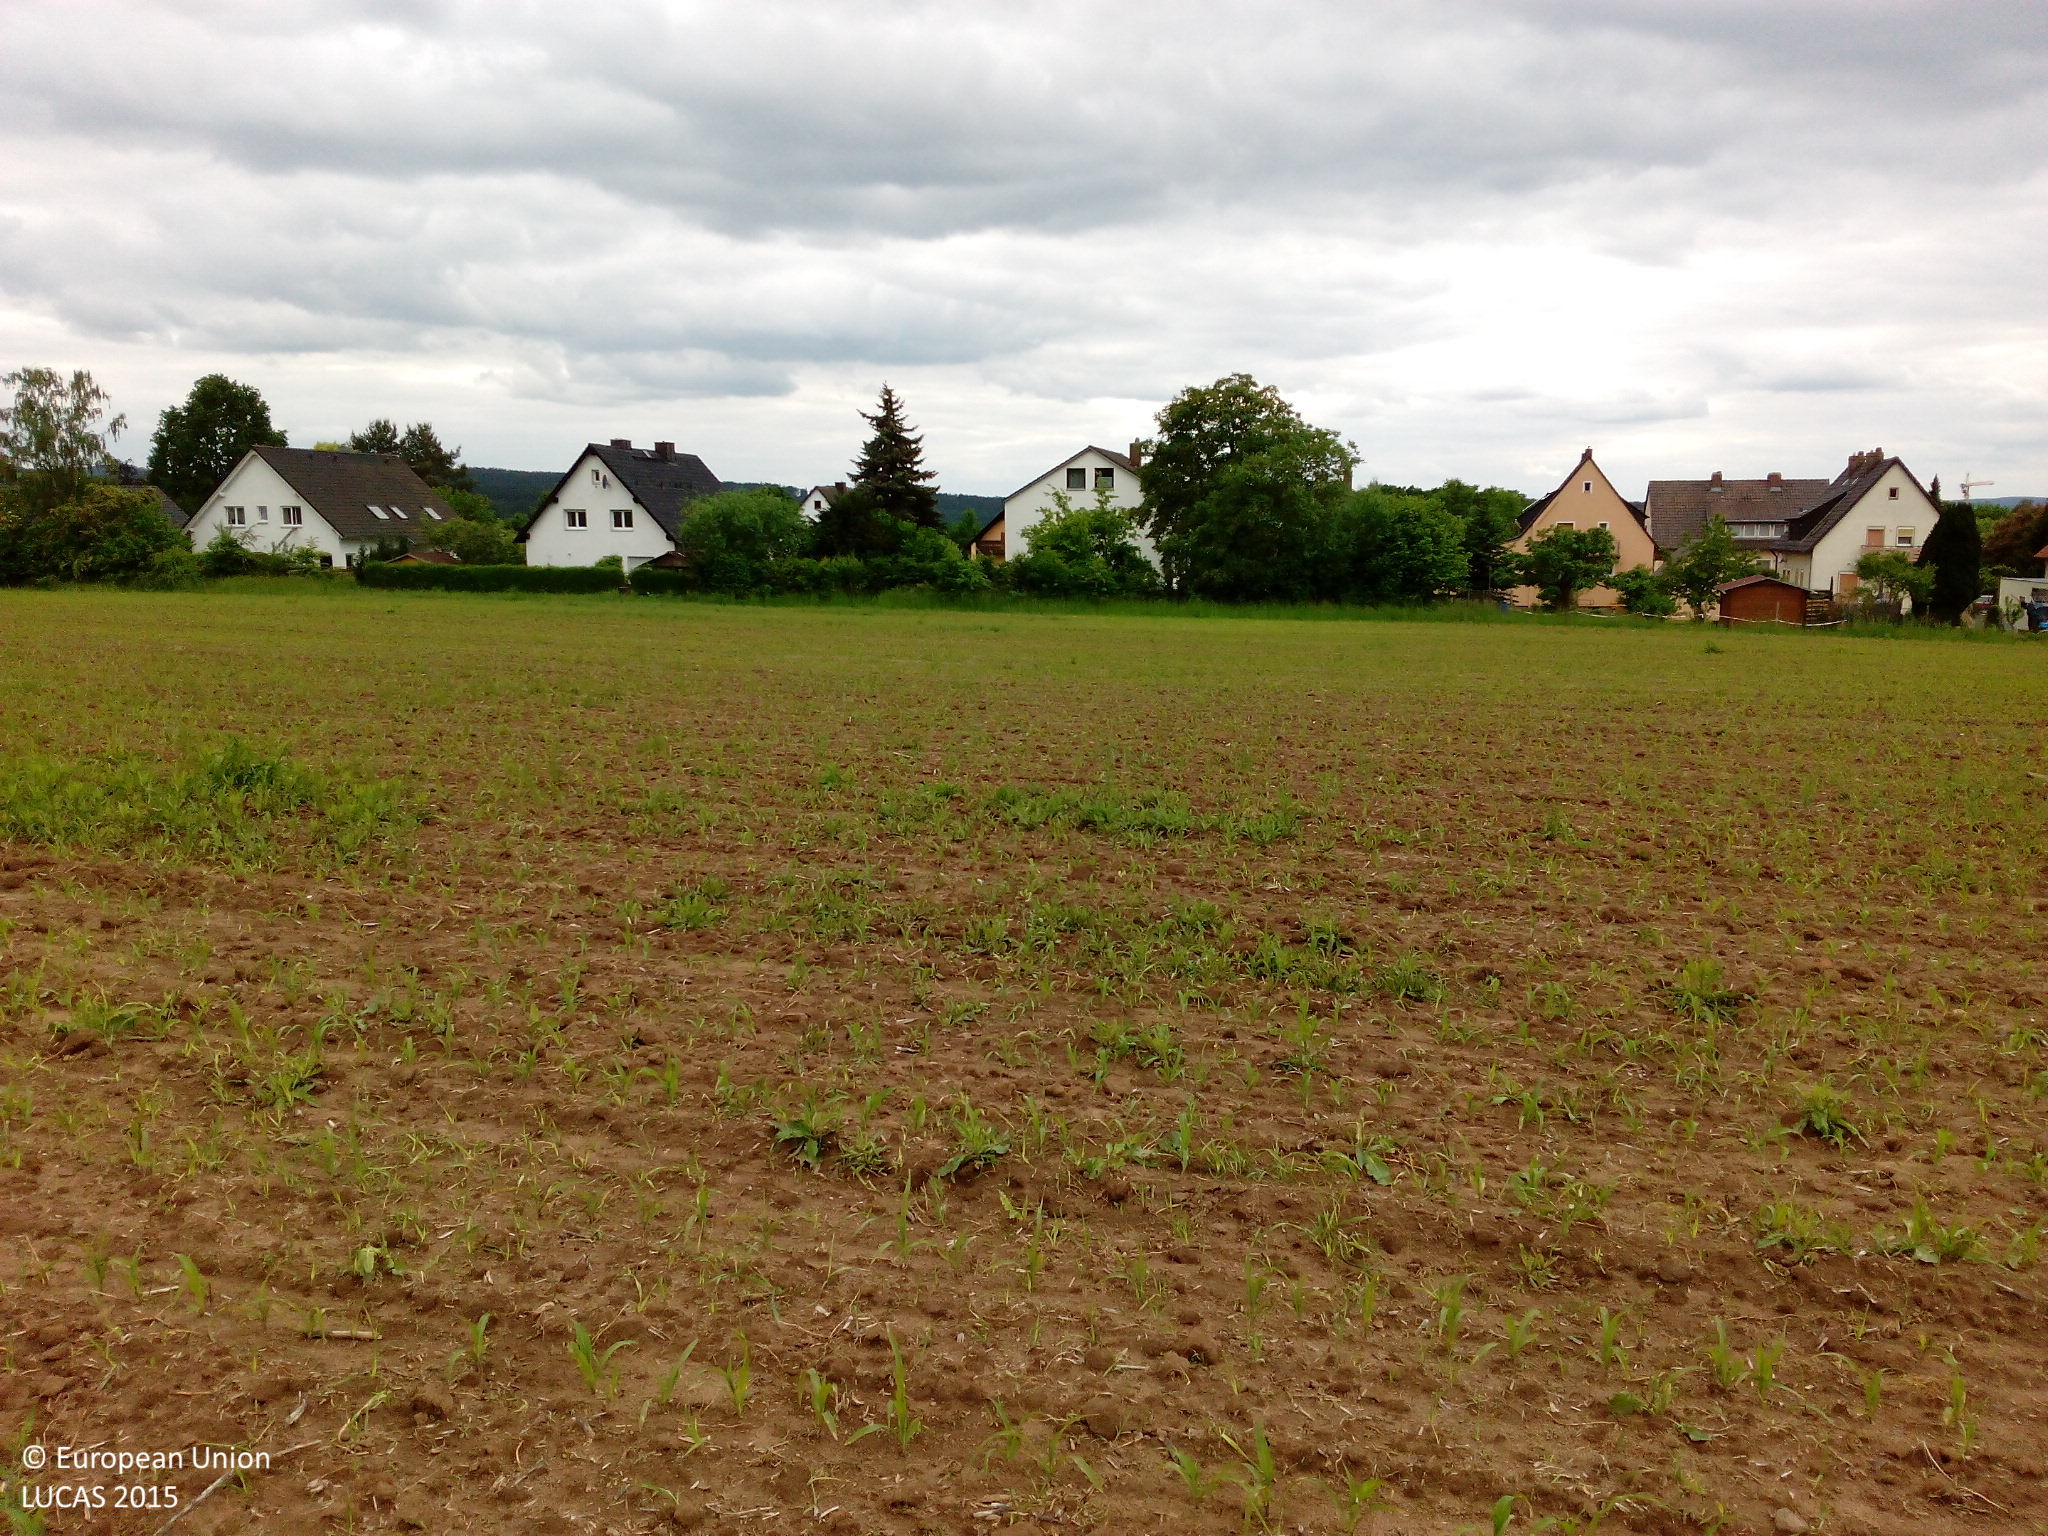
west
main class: Cropland
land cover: Maize
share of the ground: < 10 %
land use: Agriculture (excluding fallow land and kitchen gardens)
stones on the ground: < 10 %
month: May
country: DE
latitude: 49.9212
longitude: 11.6013
